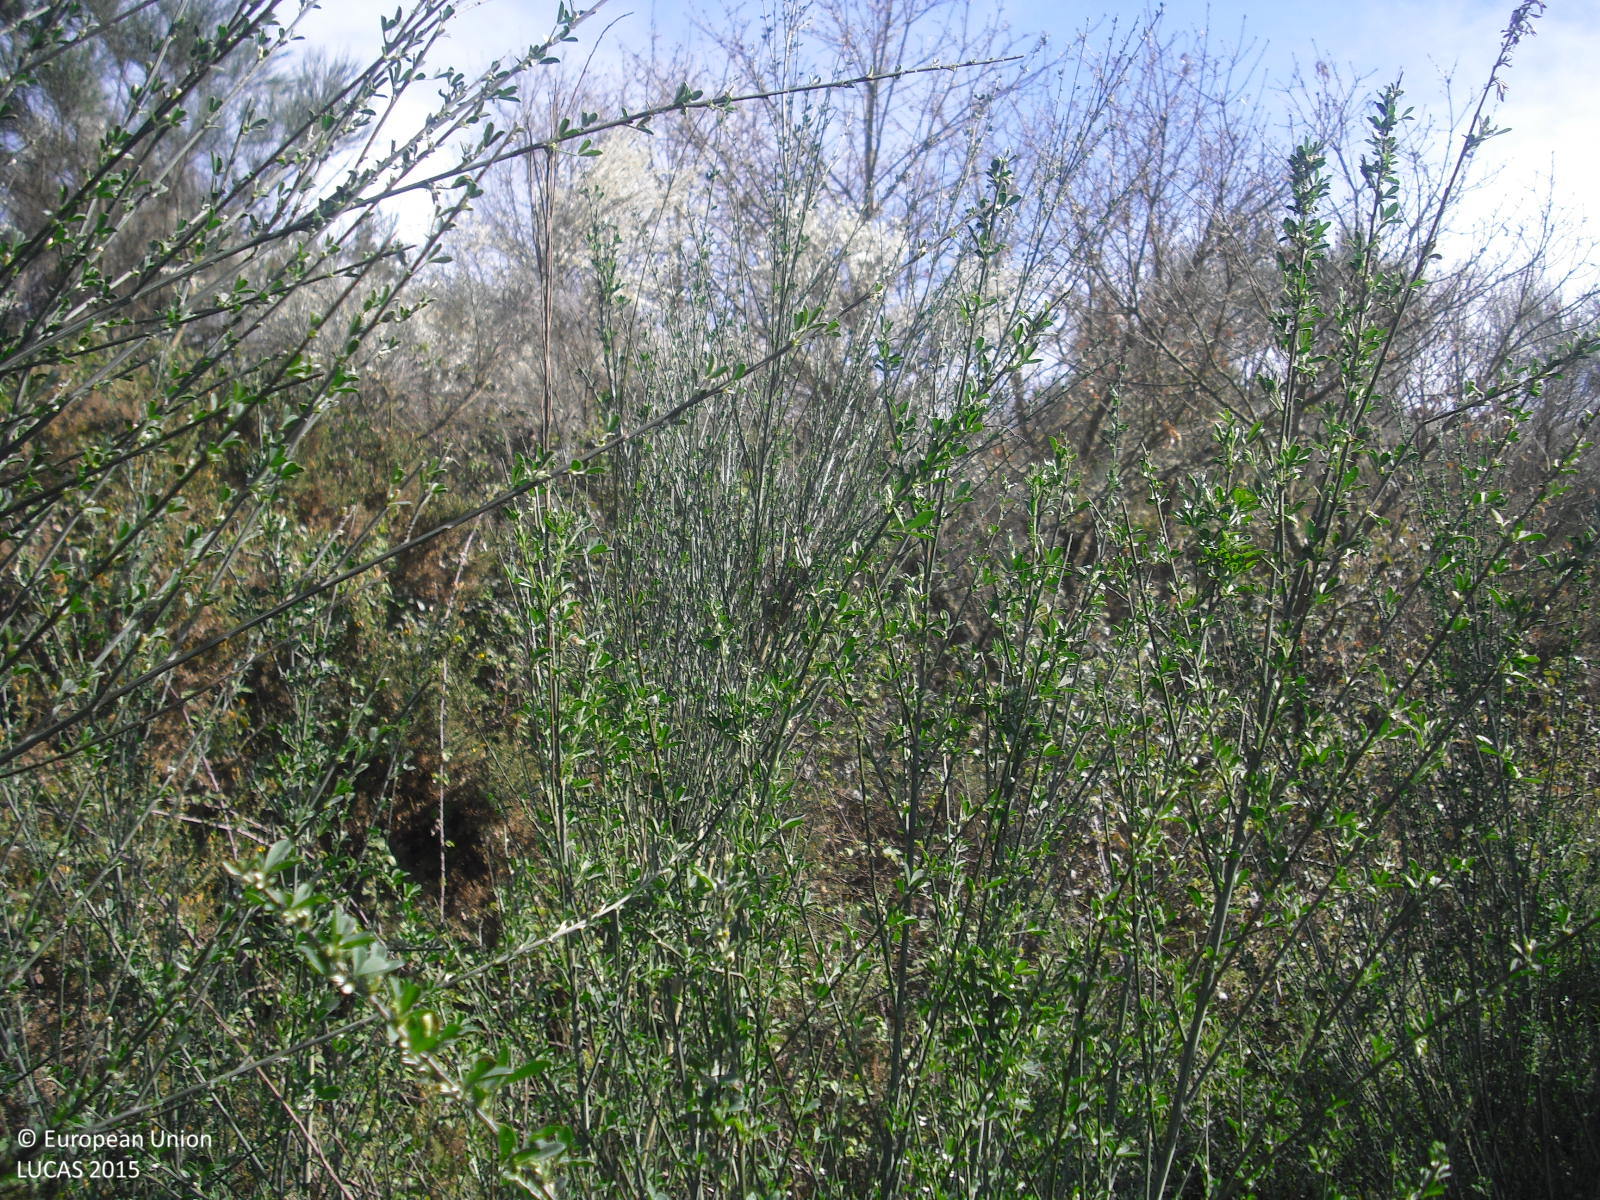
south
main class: Woodland
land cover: Broadleaved woodland
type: thermophilous deciduous forest
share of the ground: 50 - 75 %
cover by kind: broadleaved forest trees 60 %, shrubs 30 %, herbaceous plants 10 %
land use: Semi-natural and natural areas not in use
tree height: < 5 m
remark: Burnt area
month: April
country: ES
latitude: 41.9924
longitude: -7.6545
